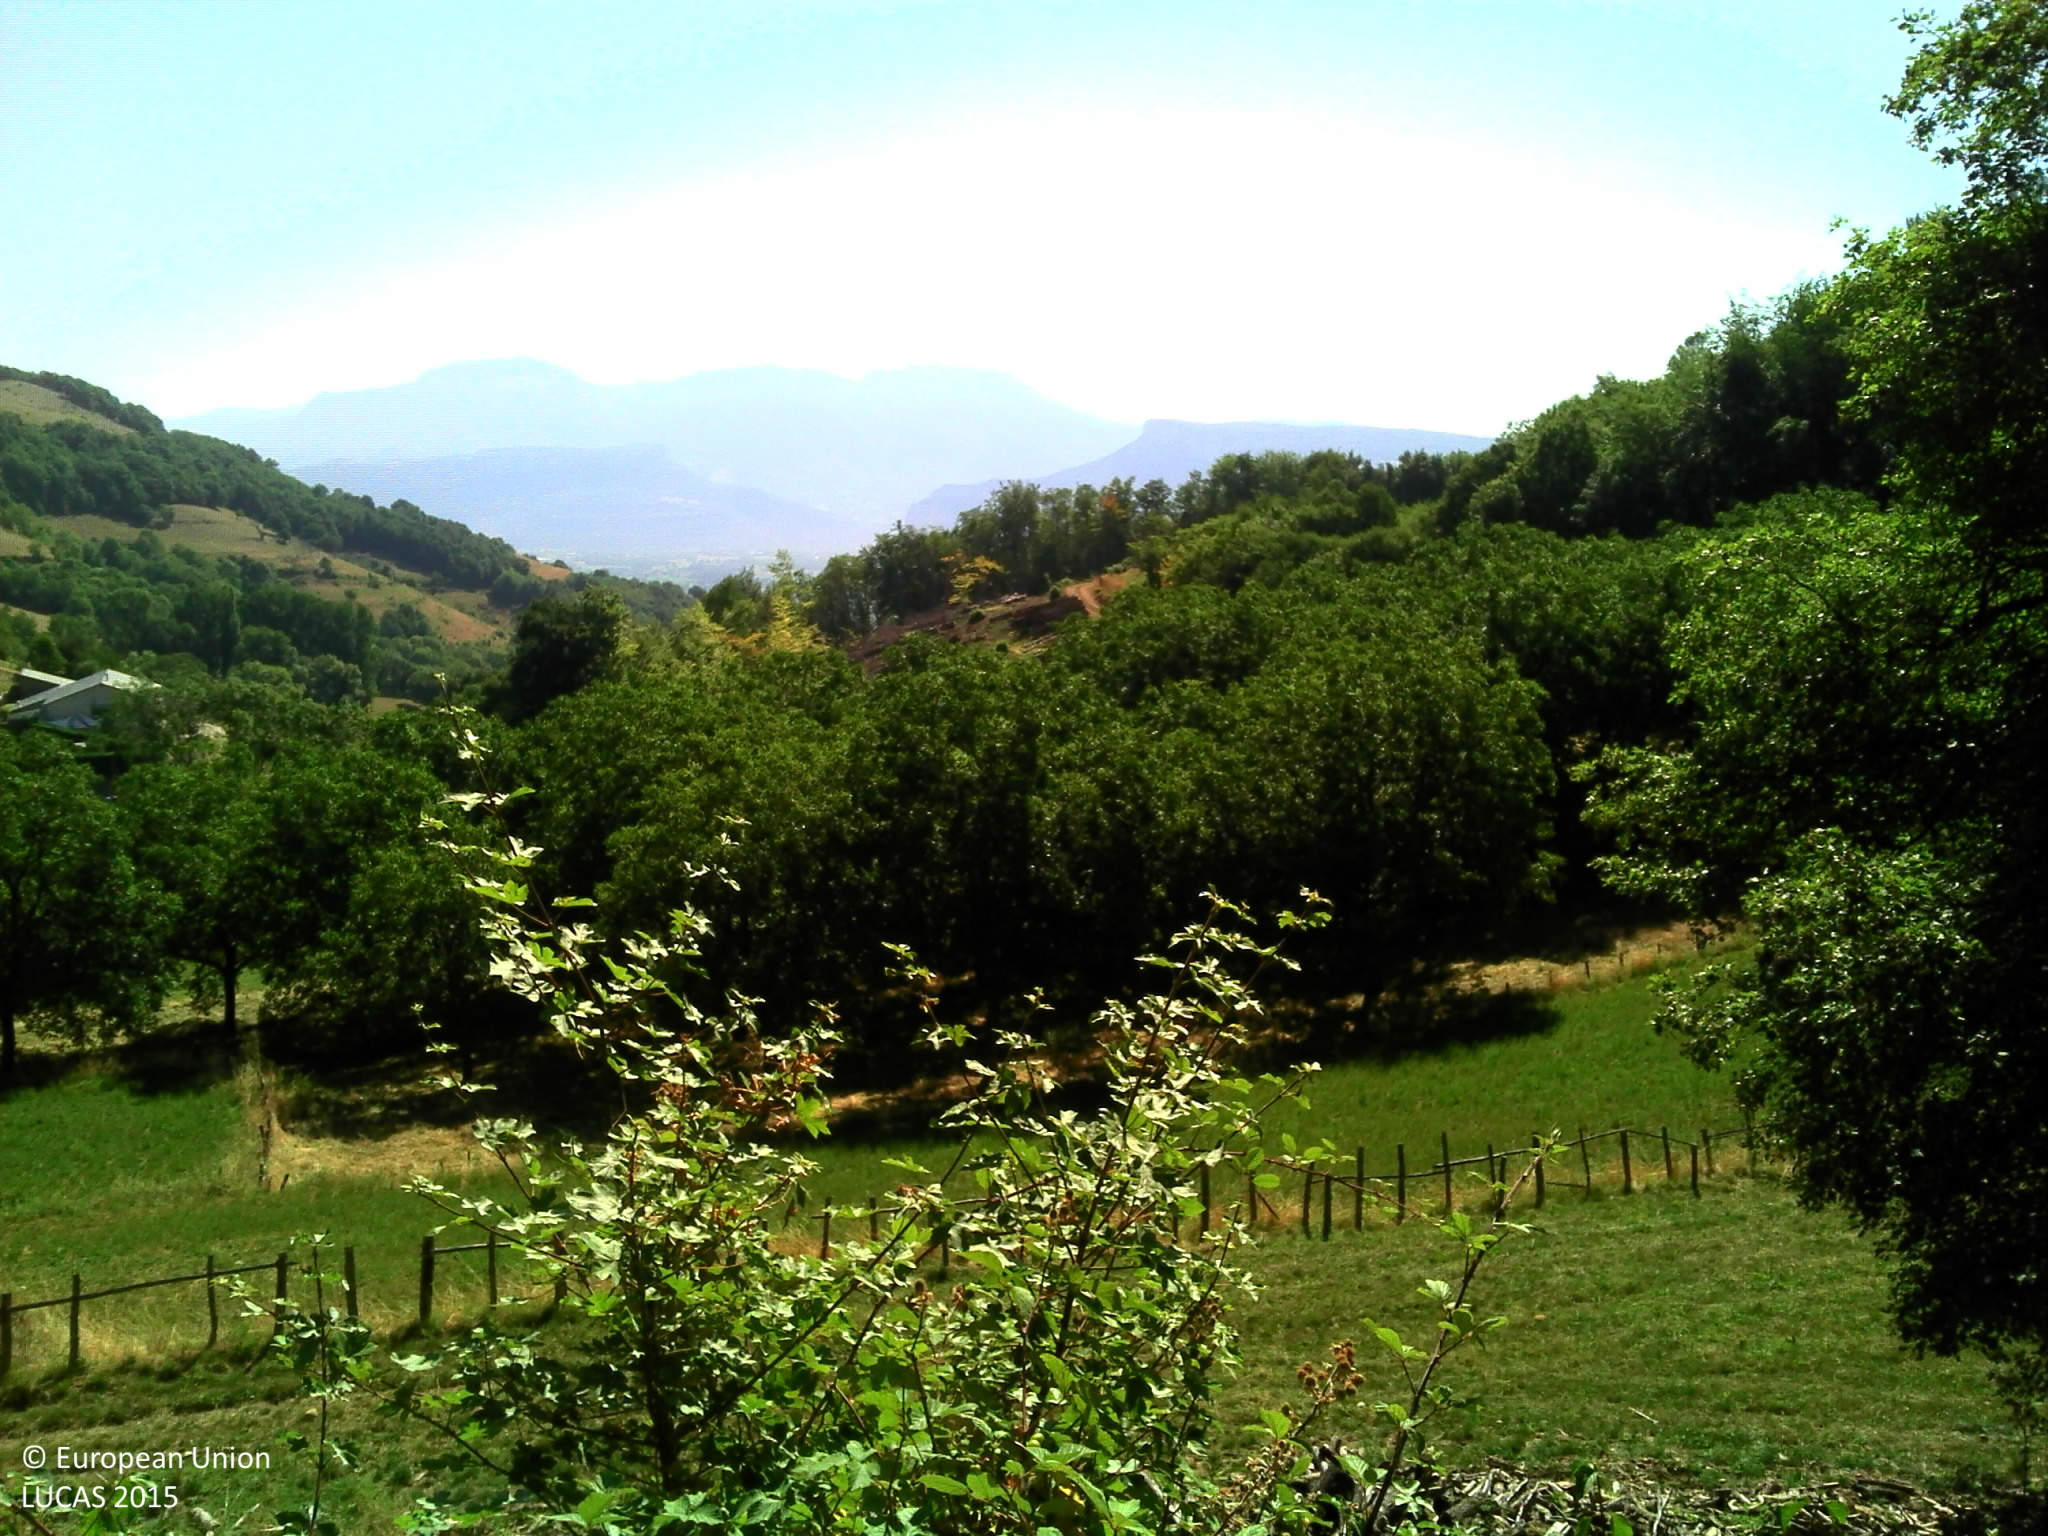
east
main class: Shrubland
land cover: Shrubland without tree cover
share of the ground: > 75 %
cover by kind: herbaceous plants 65 %, shrubs 35 %
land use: Agriculture (excluding fallow land and kitchen gardens)
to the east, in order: Shrubland without tree cover; Grassland without tree/shrub cover; Tracks; Fences; Grassland without tree/shrub cover; Fences; Nuts trees; Grassland without tree/shrub cover; Fences; Grassland without tree/shrub cover; Fences; Tracks; Broadleaved woodland; Other bare soil
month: July
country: FR
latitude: 45.2982
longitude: 5.4526
